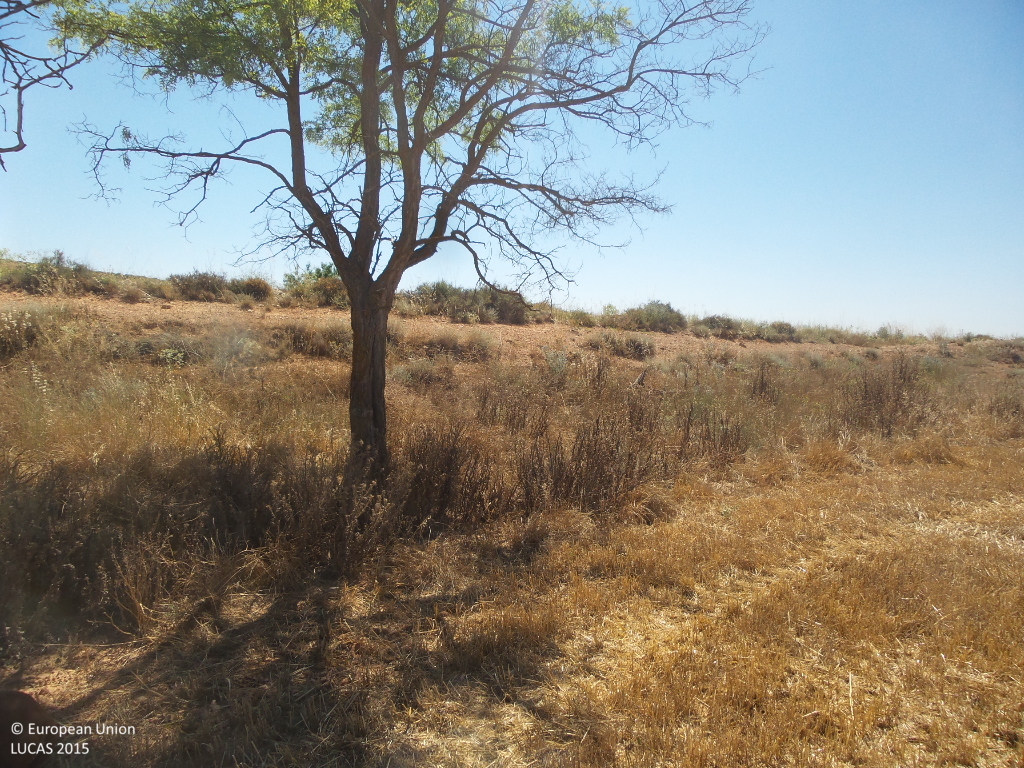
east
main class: Cropland
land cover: Common wheat
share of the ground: < 10 %
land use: Agriculture (excluding fallow land and kitchen gardens)
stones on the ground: < 10 %
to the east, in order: Common wheat; Grassland with sparse tree/shrub cover; Railways; Shrubland without tree cover; Barley; Shrubland without tree cover; Common wheat
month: July
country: ES
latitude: 41.3198
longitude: -2.1314
